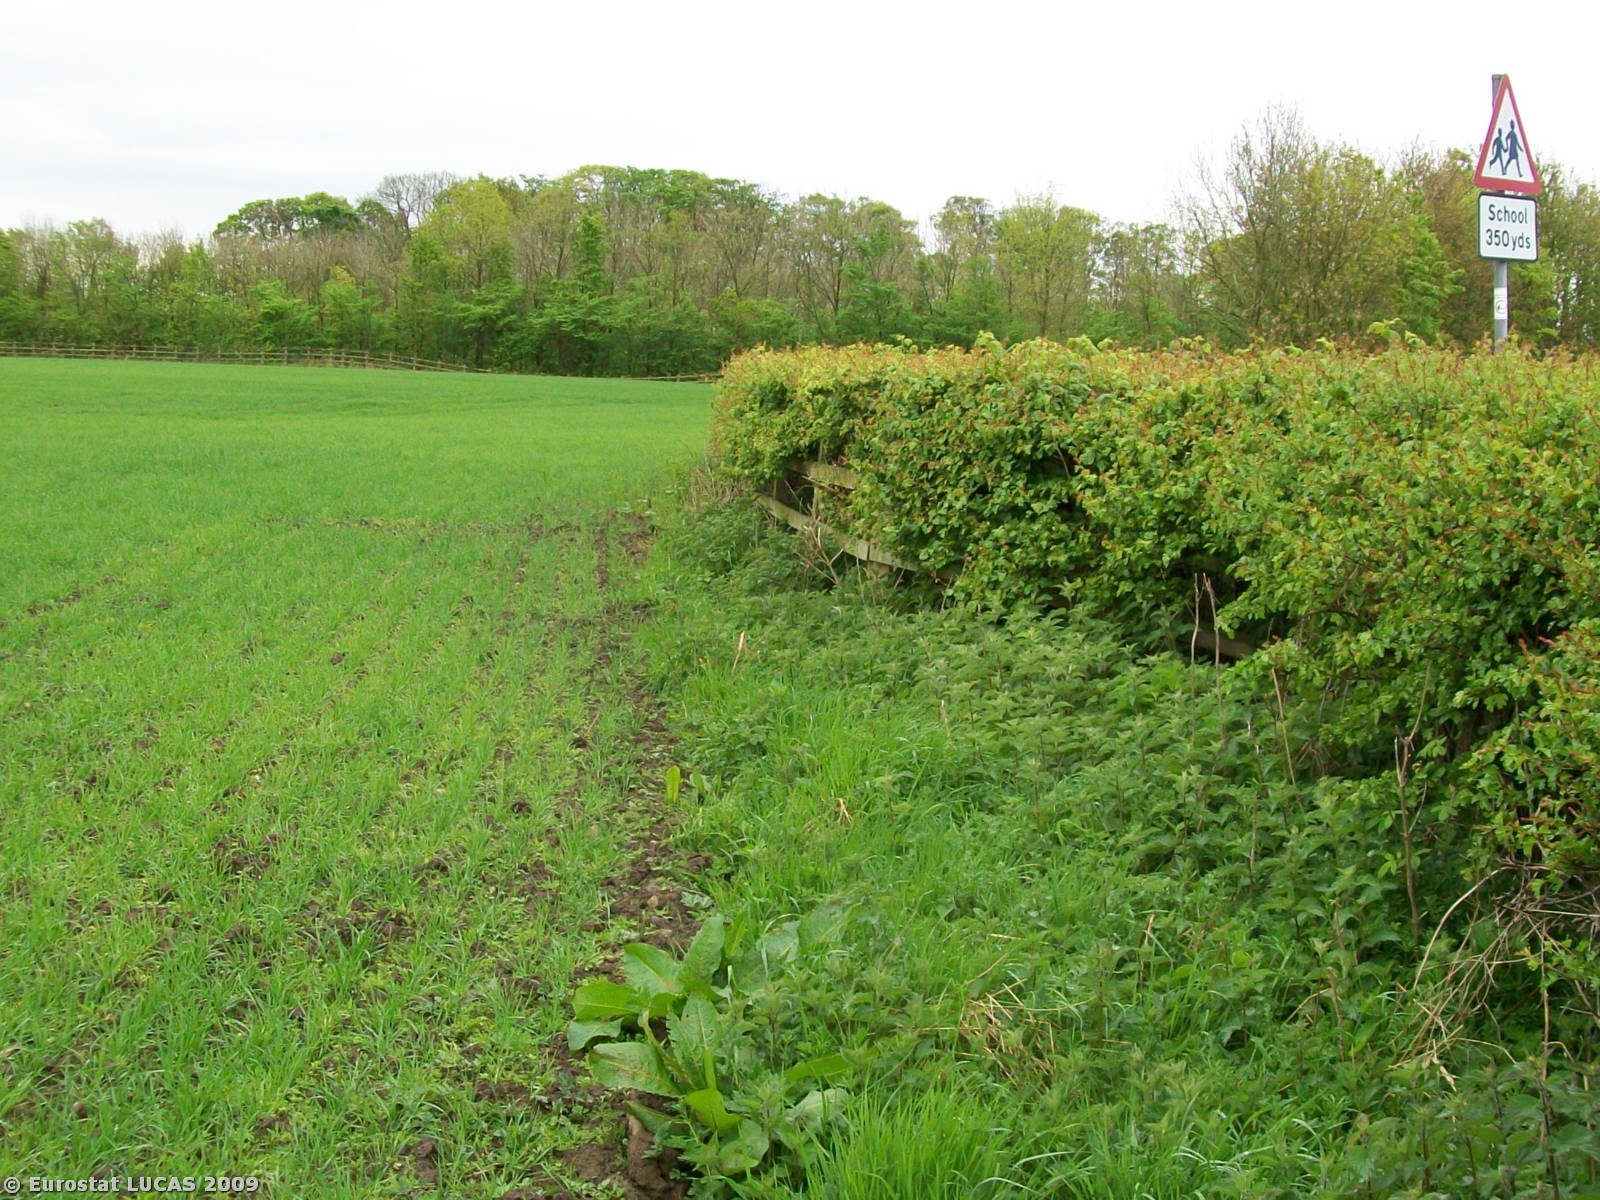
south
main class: Cropland
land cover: Common wheat
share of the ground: 50 - 75 %
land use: Agriculture (excluding fallow land and kitchen gardens)
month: May
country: GB
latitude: 53.8012
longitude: -2.9019
